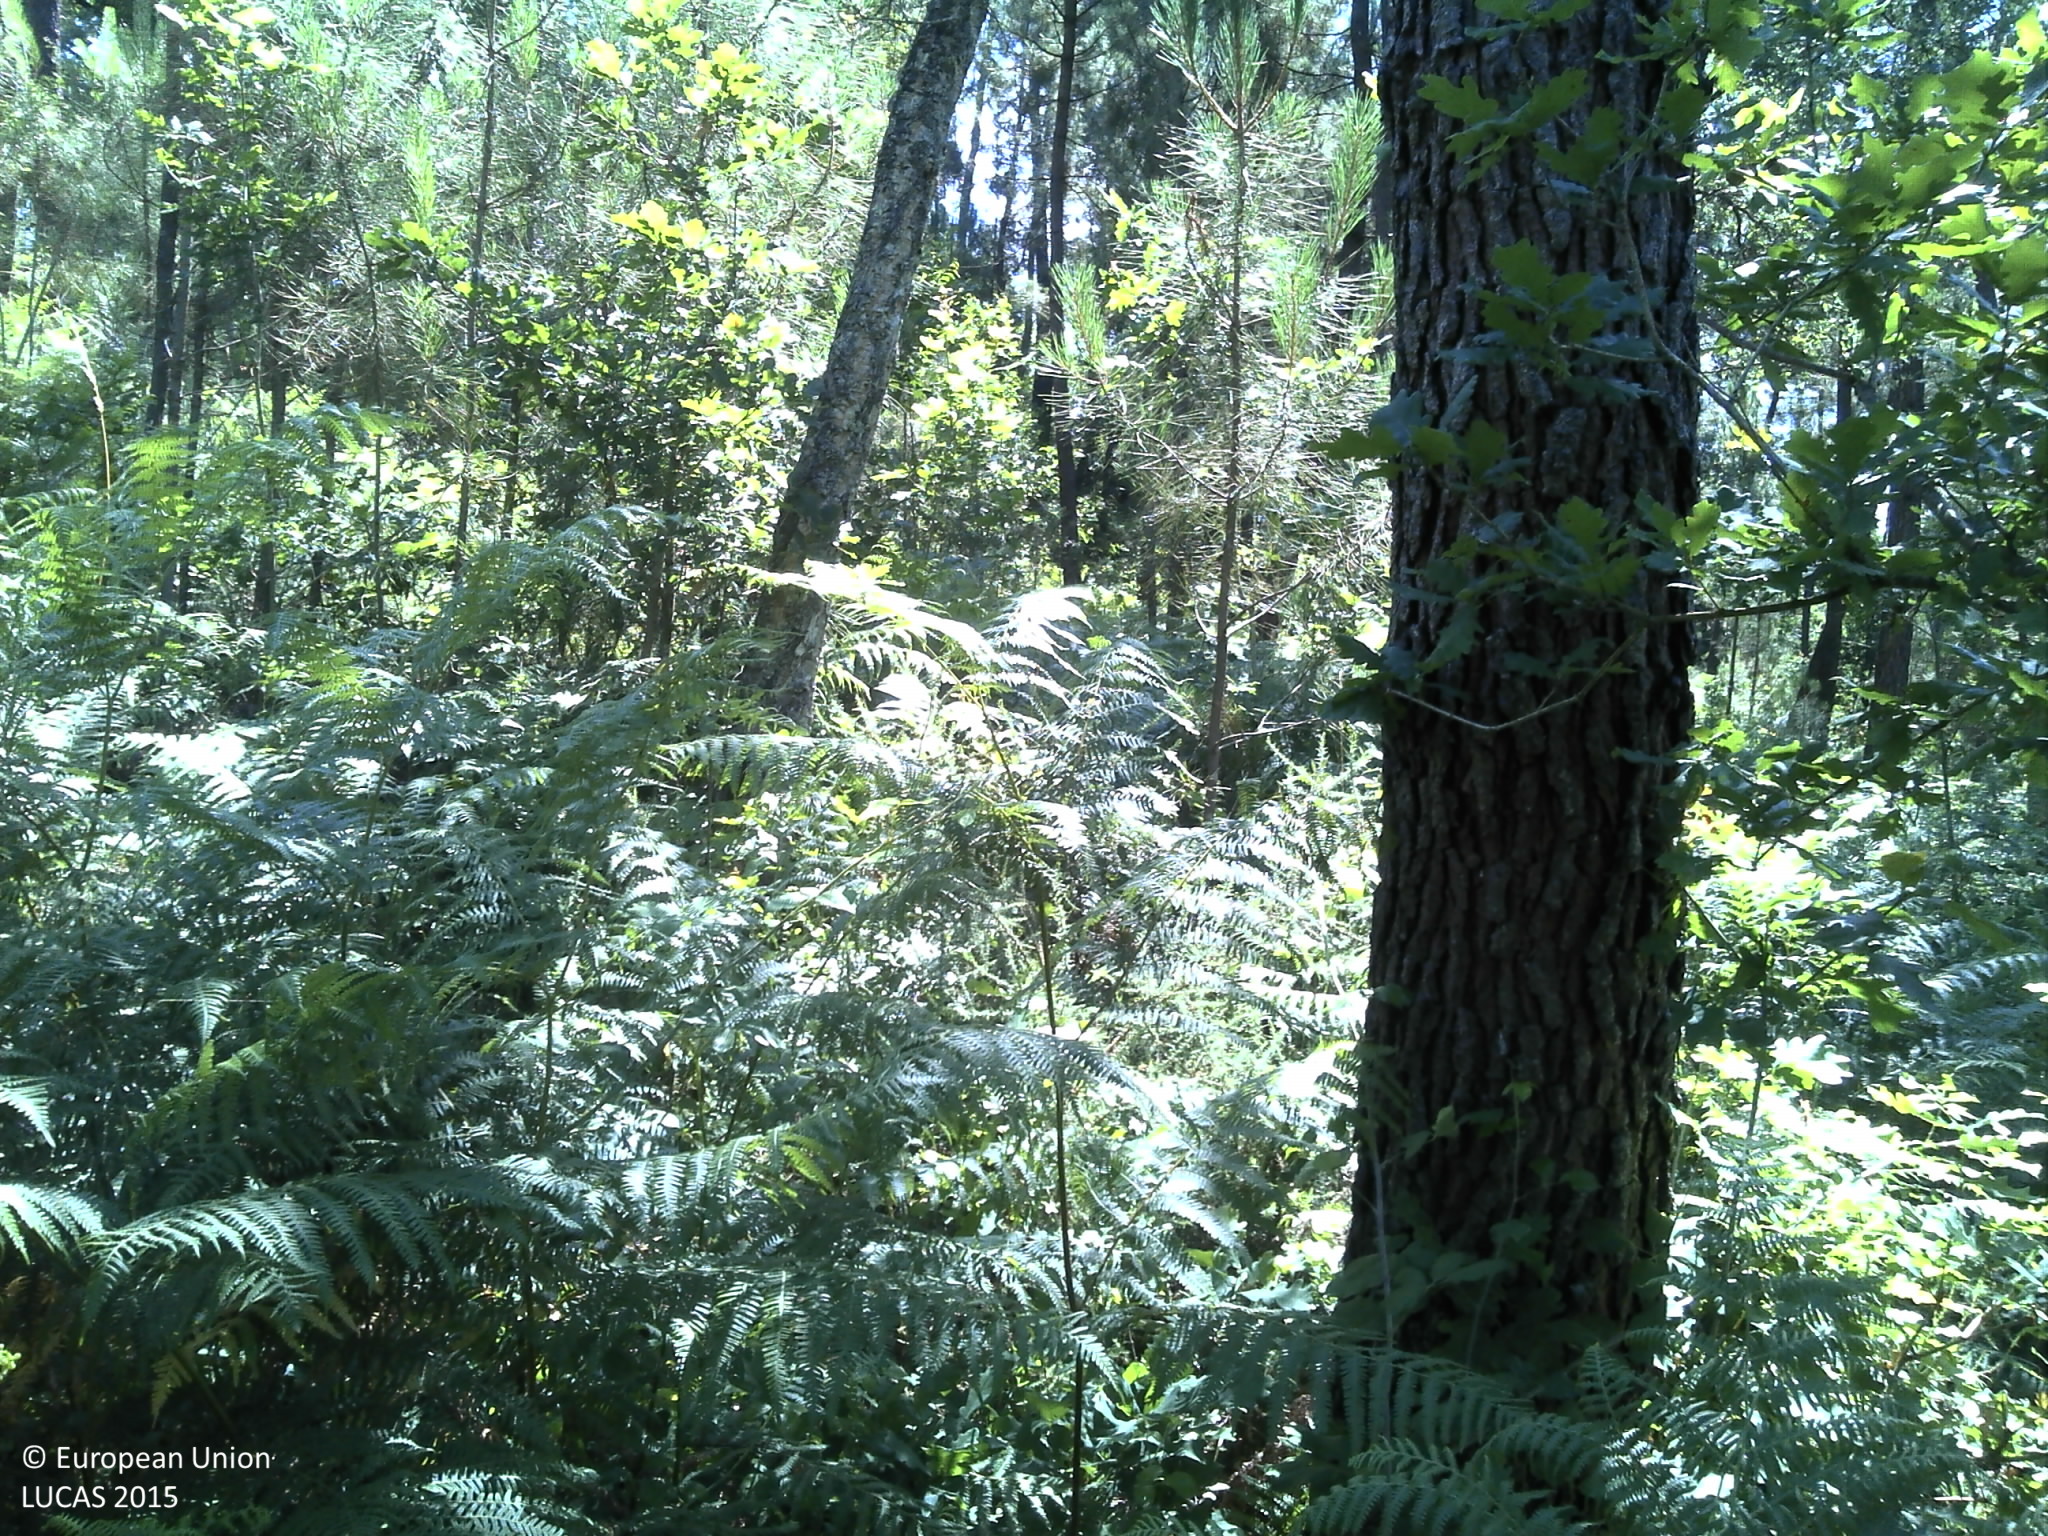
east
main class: Woodland
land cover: Pine dominated mixed woodland
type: coniferous forest of the mediterranean region
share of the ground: 25 - 50 %
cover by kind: coniferous forest trees 40 %, broadleaved forest trees 25 %, shrubs 25 %, unconsolidated bare surface 10 %
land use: Forestry
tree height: > 5 m
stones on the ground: < 10 %
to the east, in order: Pine dominated mixed woodland; Pine dominated coniferous woodland; Fences; Grassland with sparse tree/shrub cover; Broadleaved woodland; Electric lines; Shrubland with sparse tree cover; Paved roads, cycling and walking lanes; Grass margins; Ditches and canals; Broadleaved woodland; Vineyards; Spontaneously vegetated surfaces; Artificial constructions in urban areas; Spontaneously vegetated surfaces; Maize
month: June
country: PT
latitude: 40.8319
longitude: -8.0491
